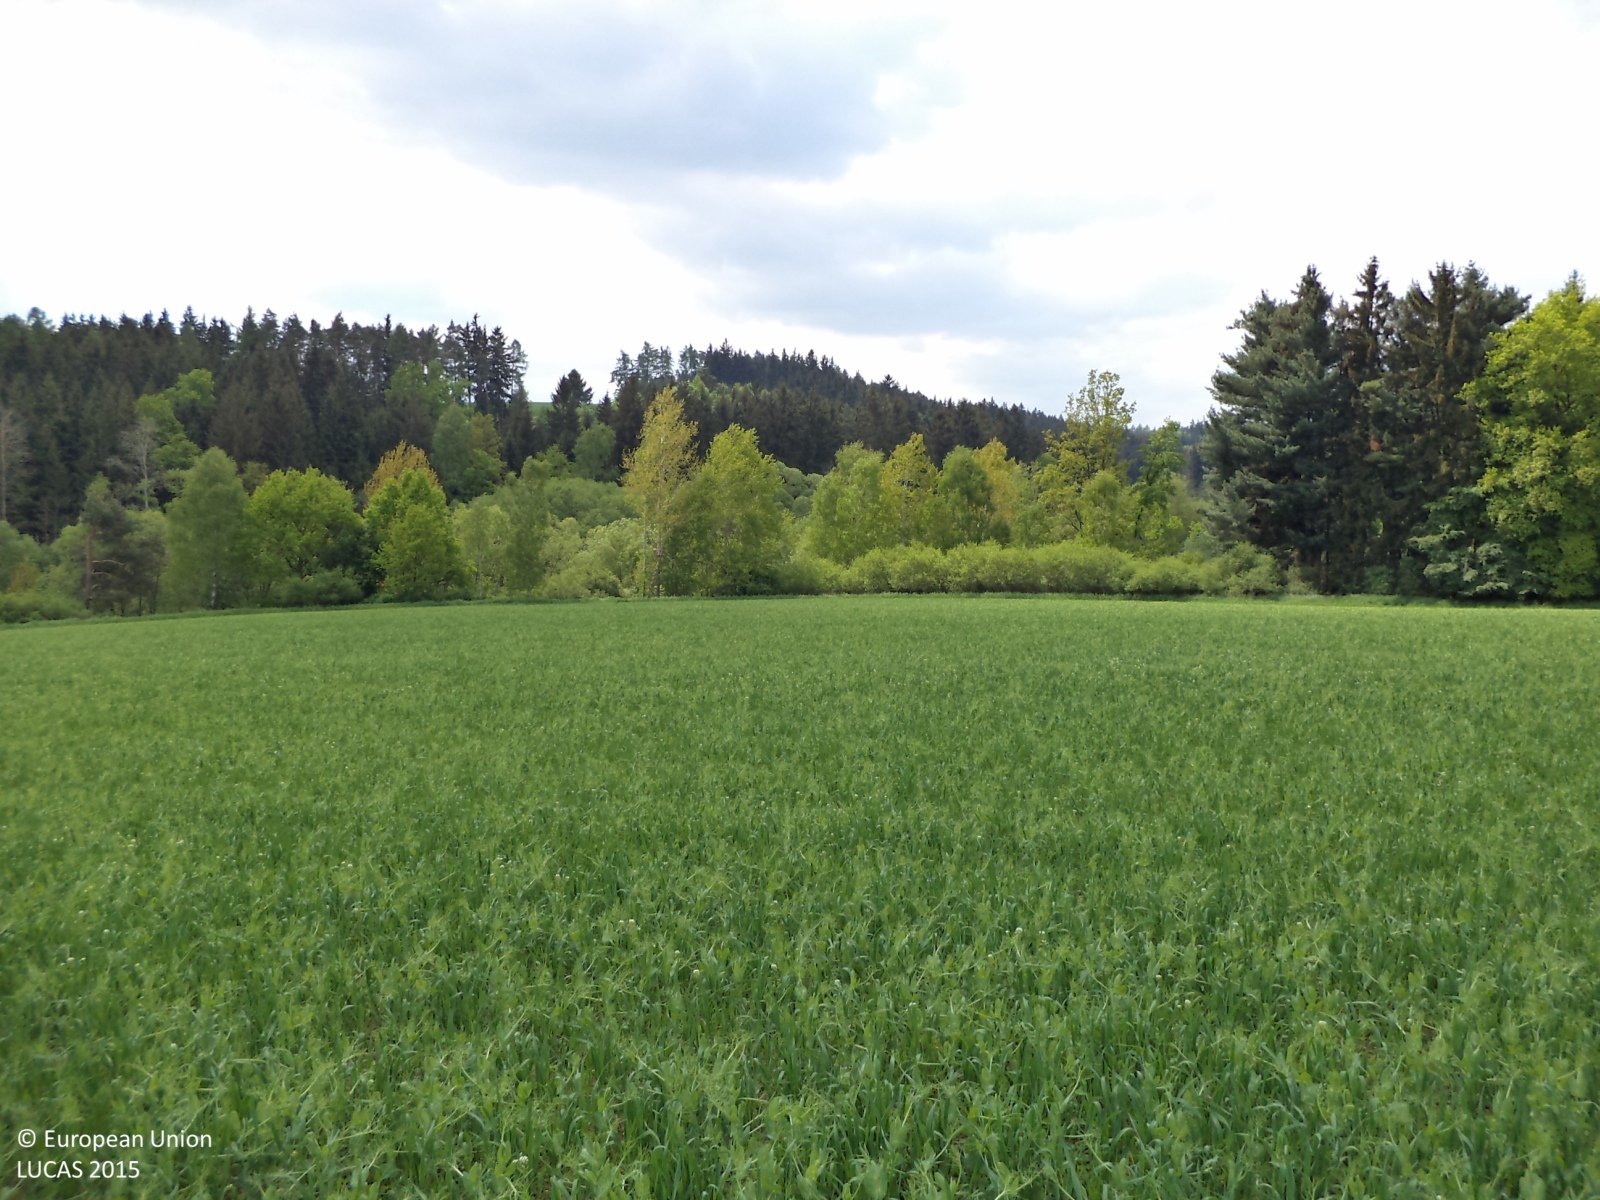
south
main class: Cropland
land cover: Mixed cereals for fodder
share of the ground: > 75 %
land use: Agriculture (excluding fallow land and kitchen gardens)
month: May
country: CZ
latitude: 49.5833
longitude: 15.1066
